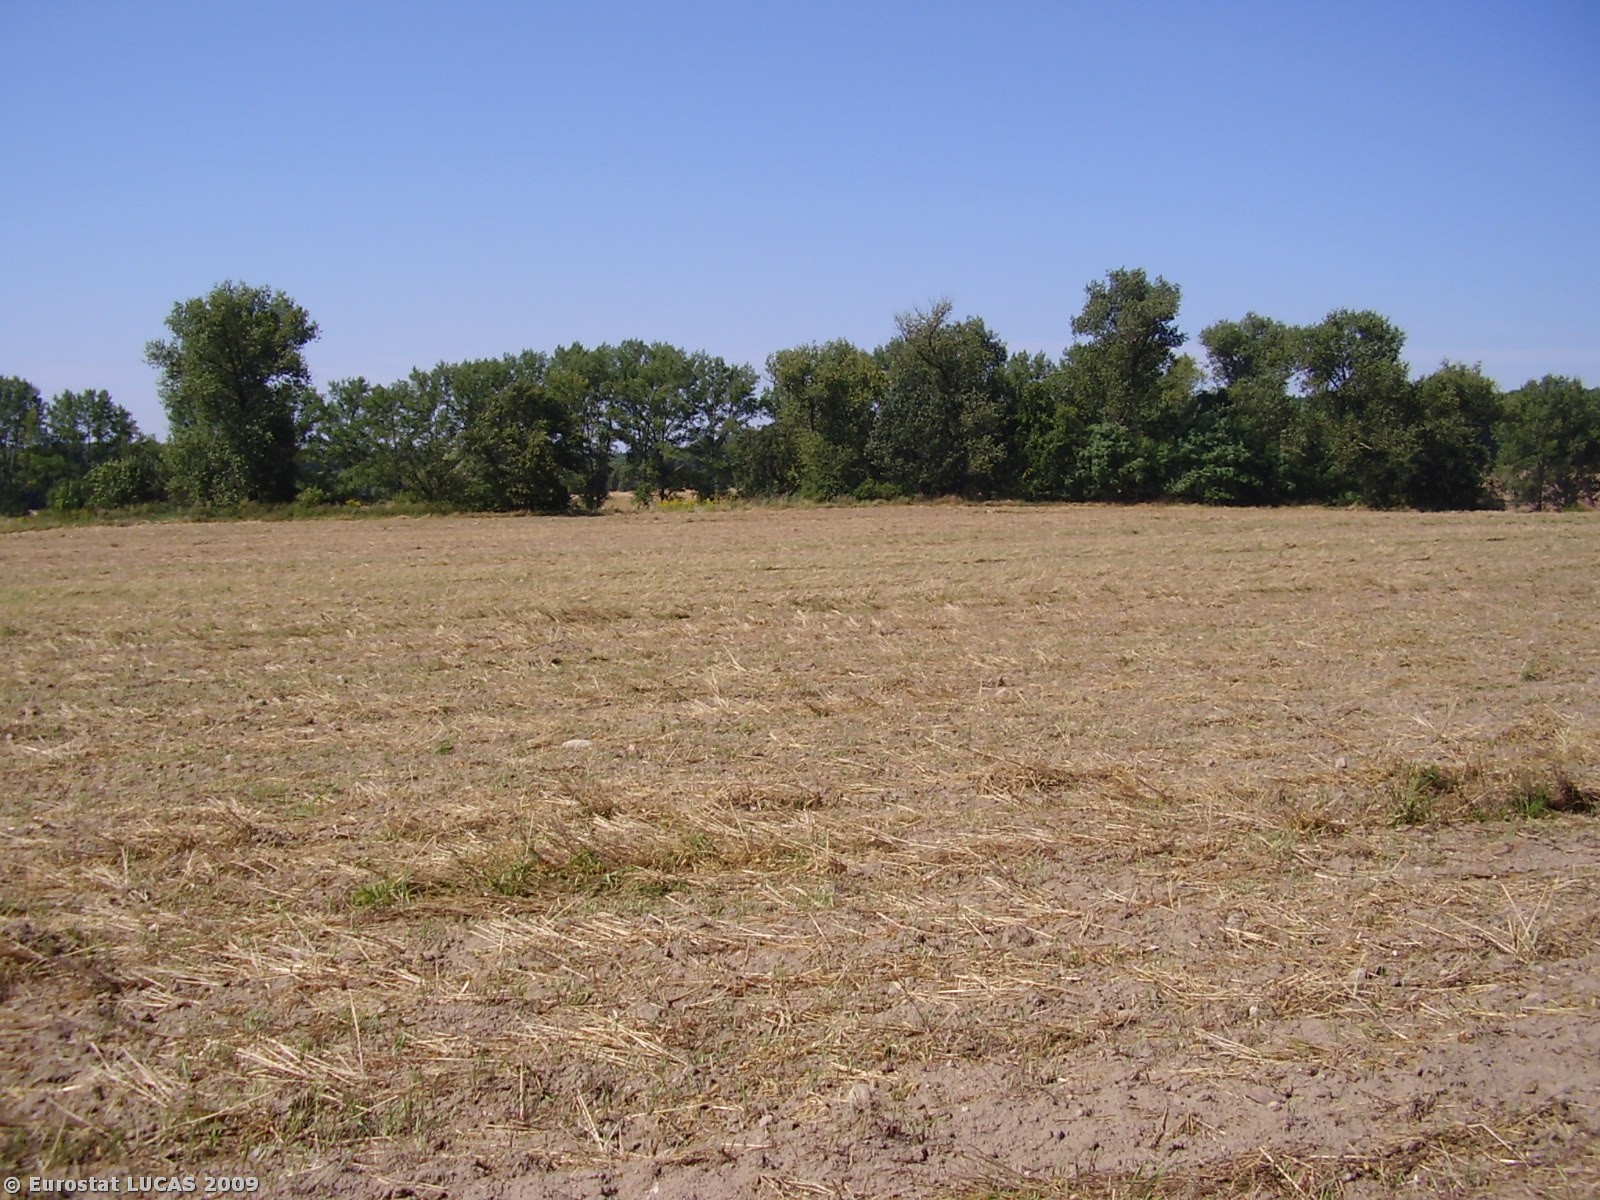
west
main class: Cropland
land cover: Rye
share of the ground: < 10 %
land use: Agriculture (excluding fallow land and kitchen gardens)
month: August
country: PL
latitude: 51.3906
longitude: 16.1140
